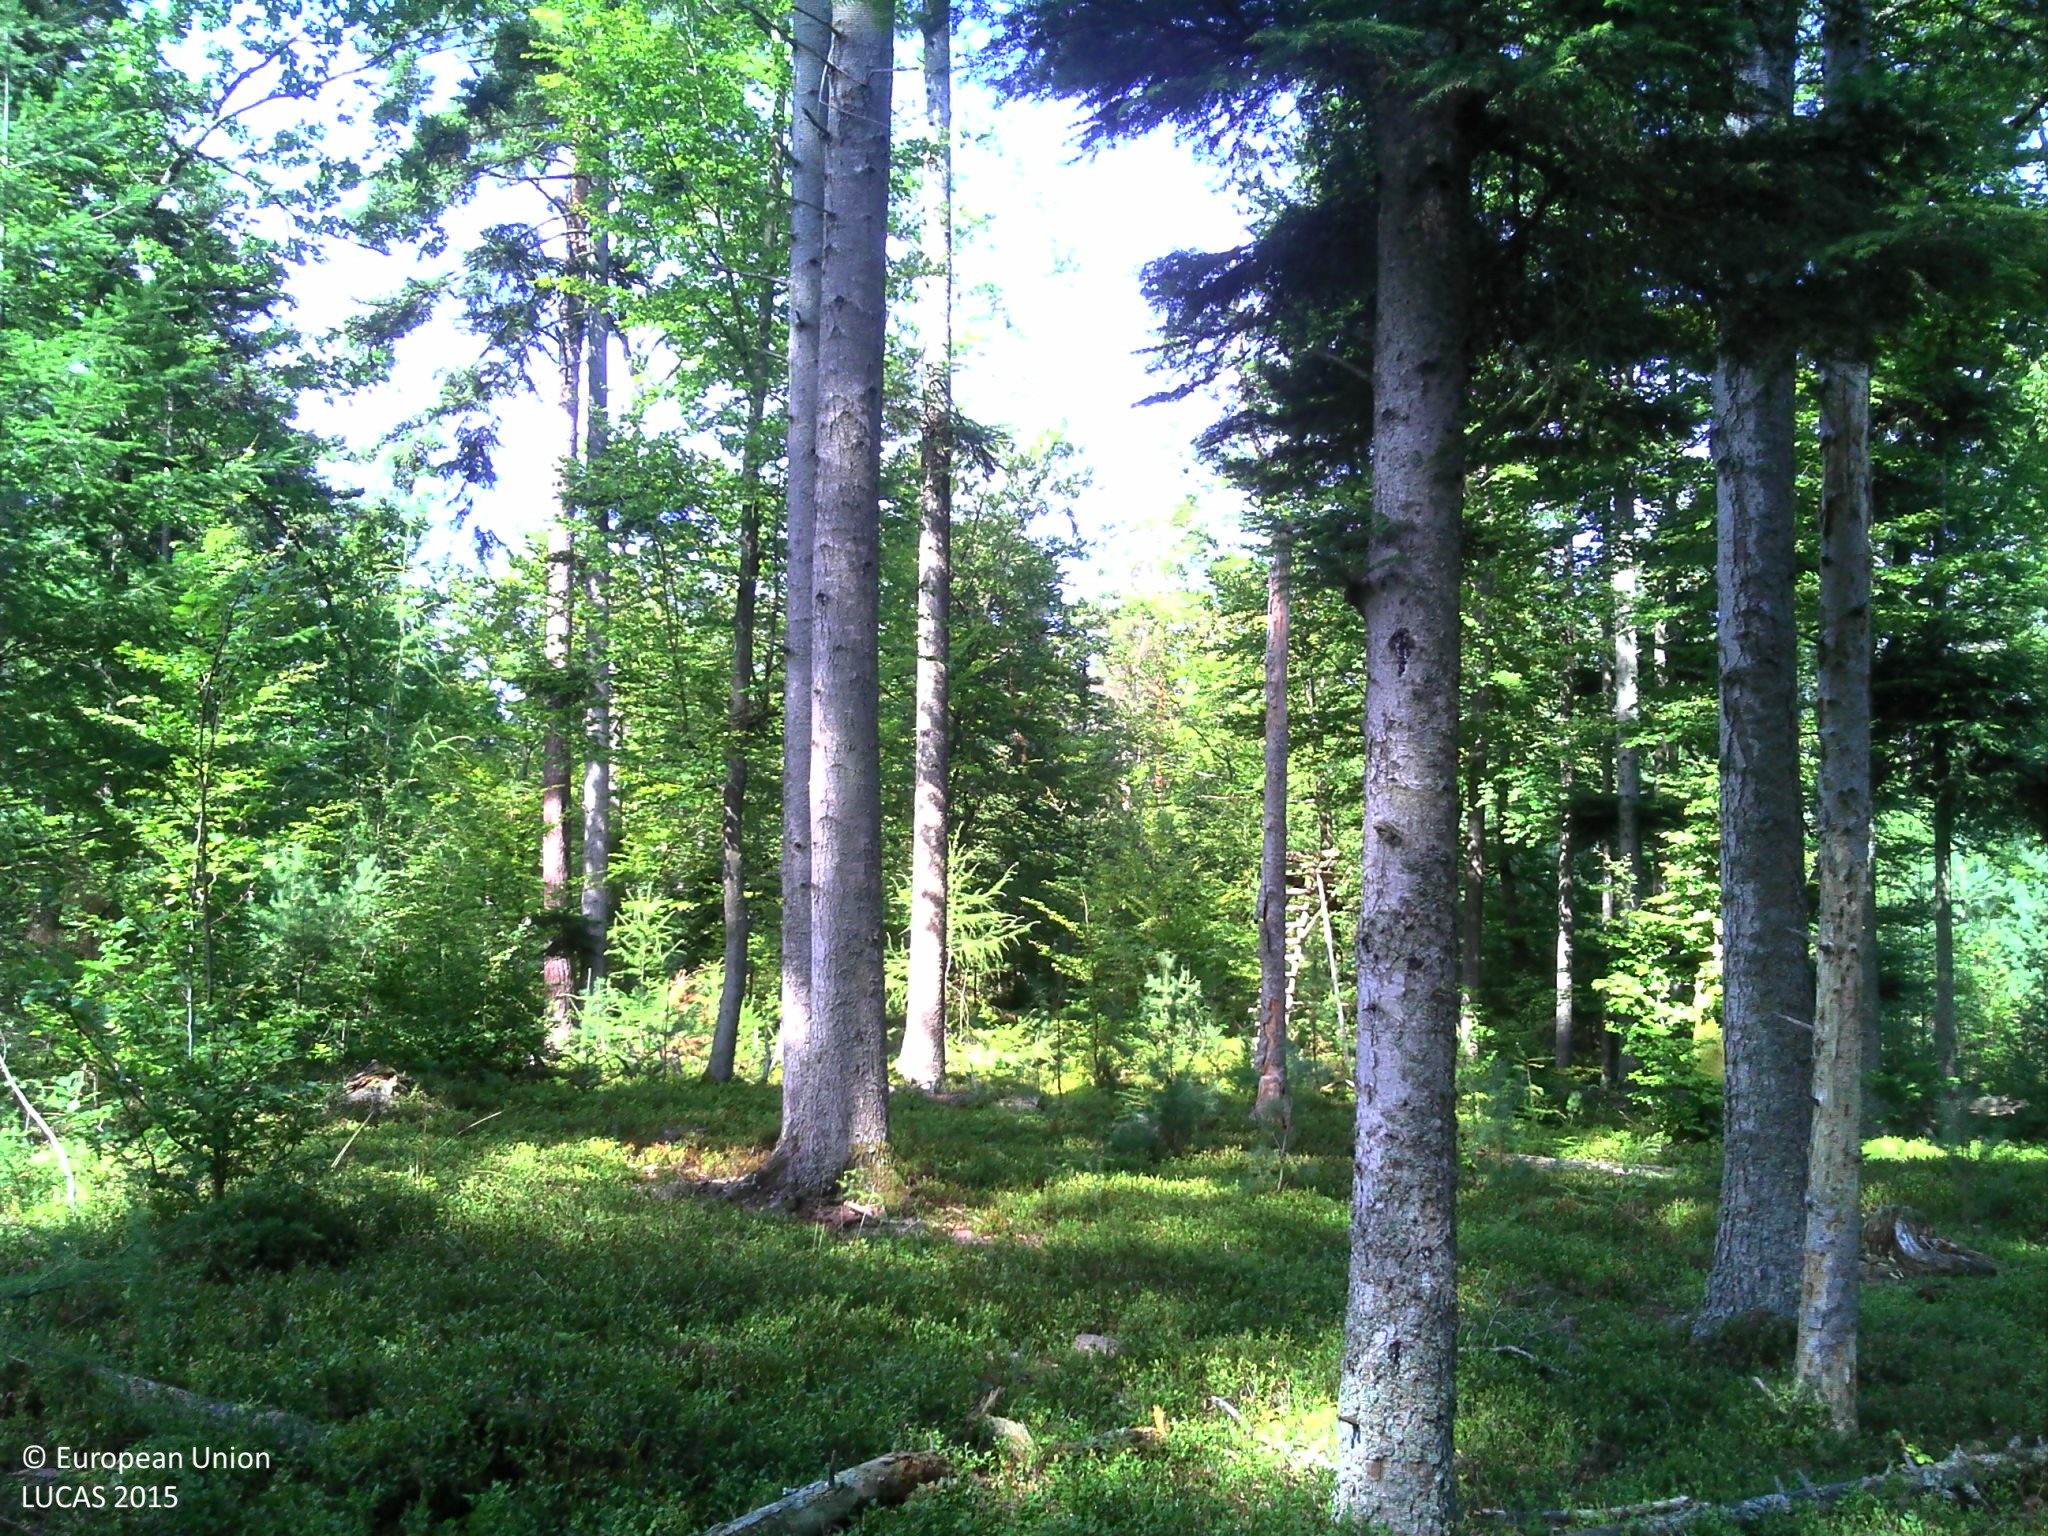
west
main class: Woodland
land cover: Spruce dominated mixed woodland
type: hemiboreal forest and nemoral coniferous forest and mixed broadleaved-coniferous forest
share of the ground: > 75 %
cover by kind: coniferous forest trees 60 %, broadleaved forest trees 30 %, herbaceous plants 10 %
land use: Forestry
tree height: > 5 m
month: August
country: FR
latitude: 48.2637
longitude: 7.3472
